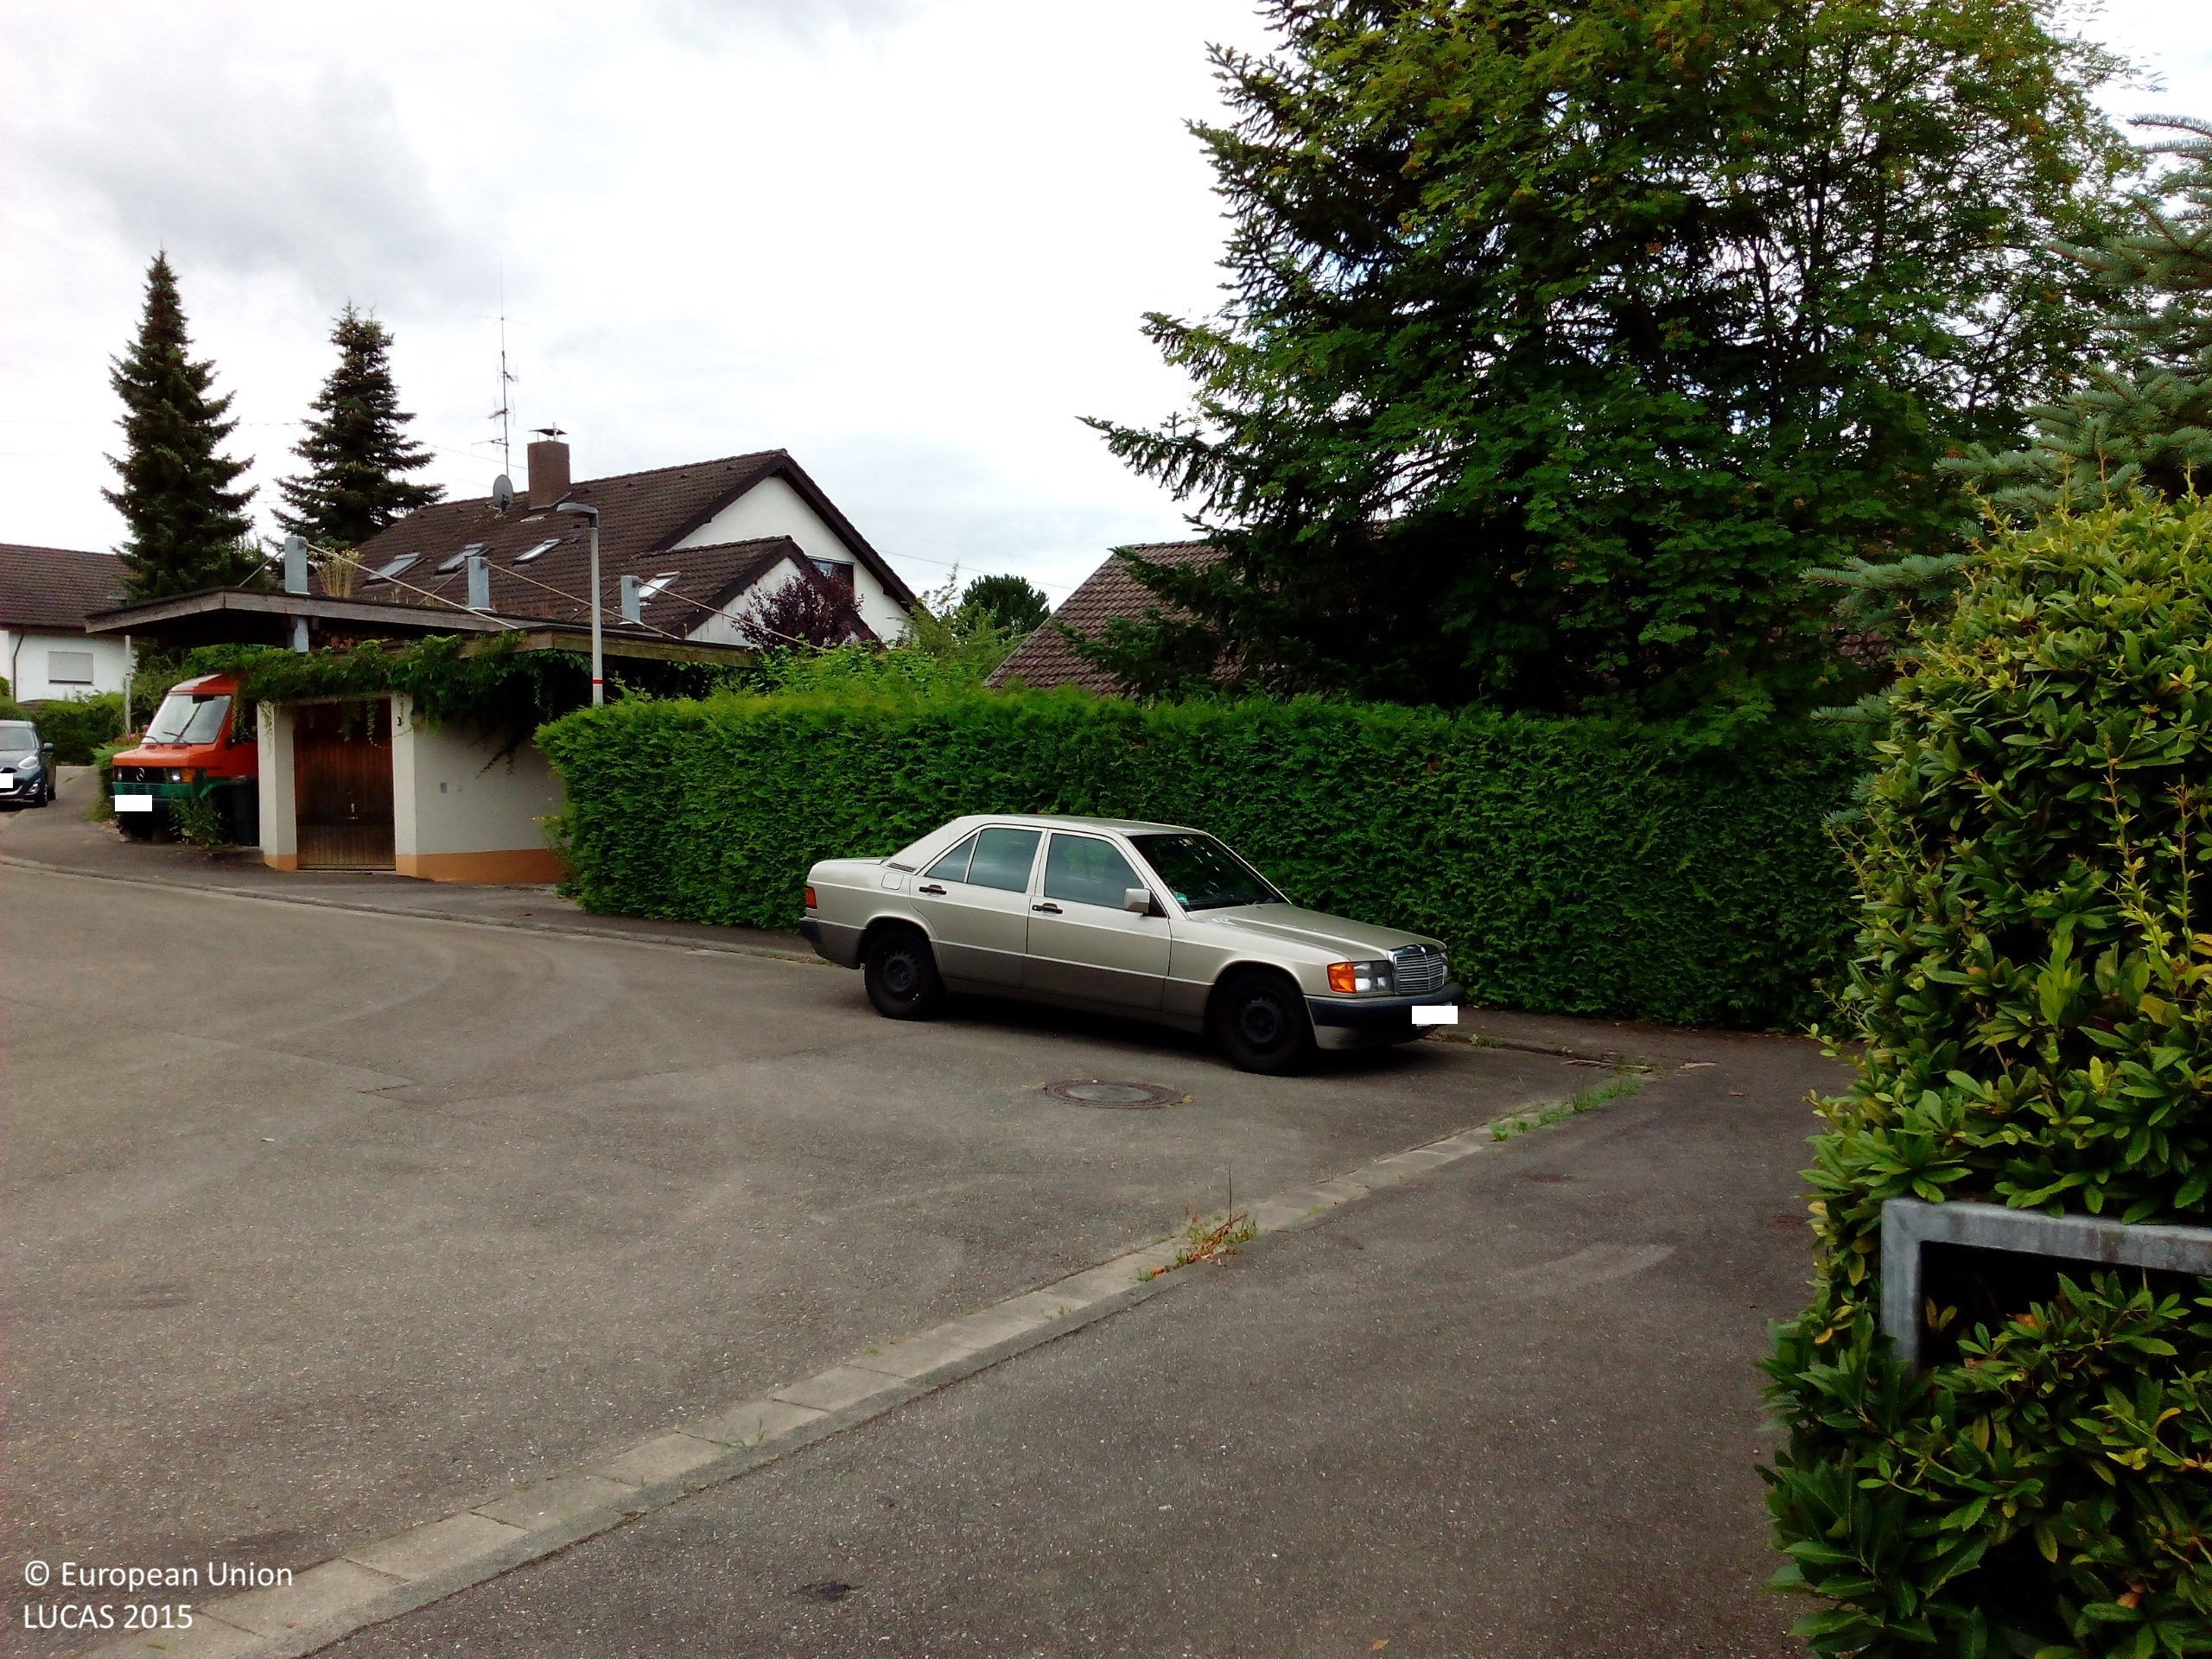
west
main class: Woodland
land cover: Other coniferous woodland
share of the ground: 50 - 75 %
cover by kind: coniferous forest trees 60 %, shrubs 30 %, herbaceous plants 5 %, consolidated bare surface 5 %
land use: Residential
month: July
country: DE
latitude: 47.6403
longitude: 7.6455
